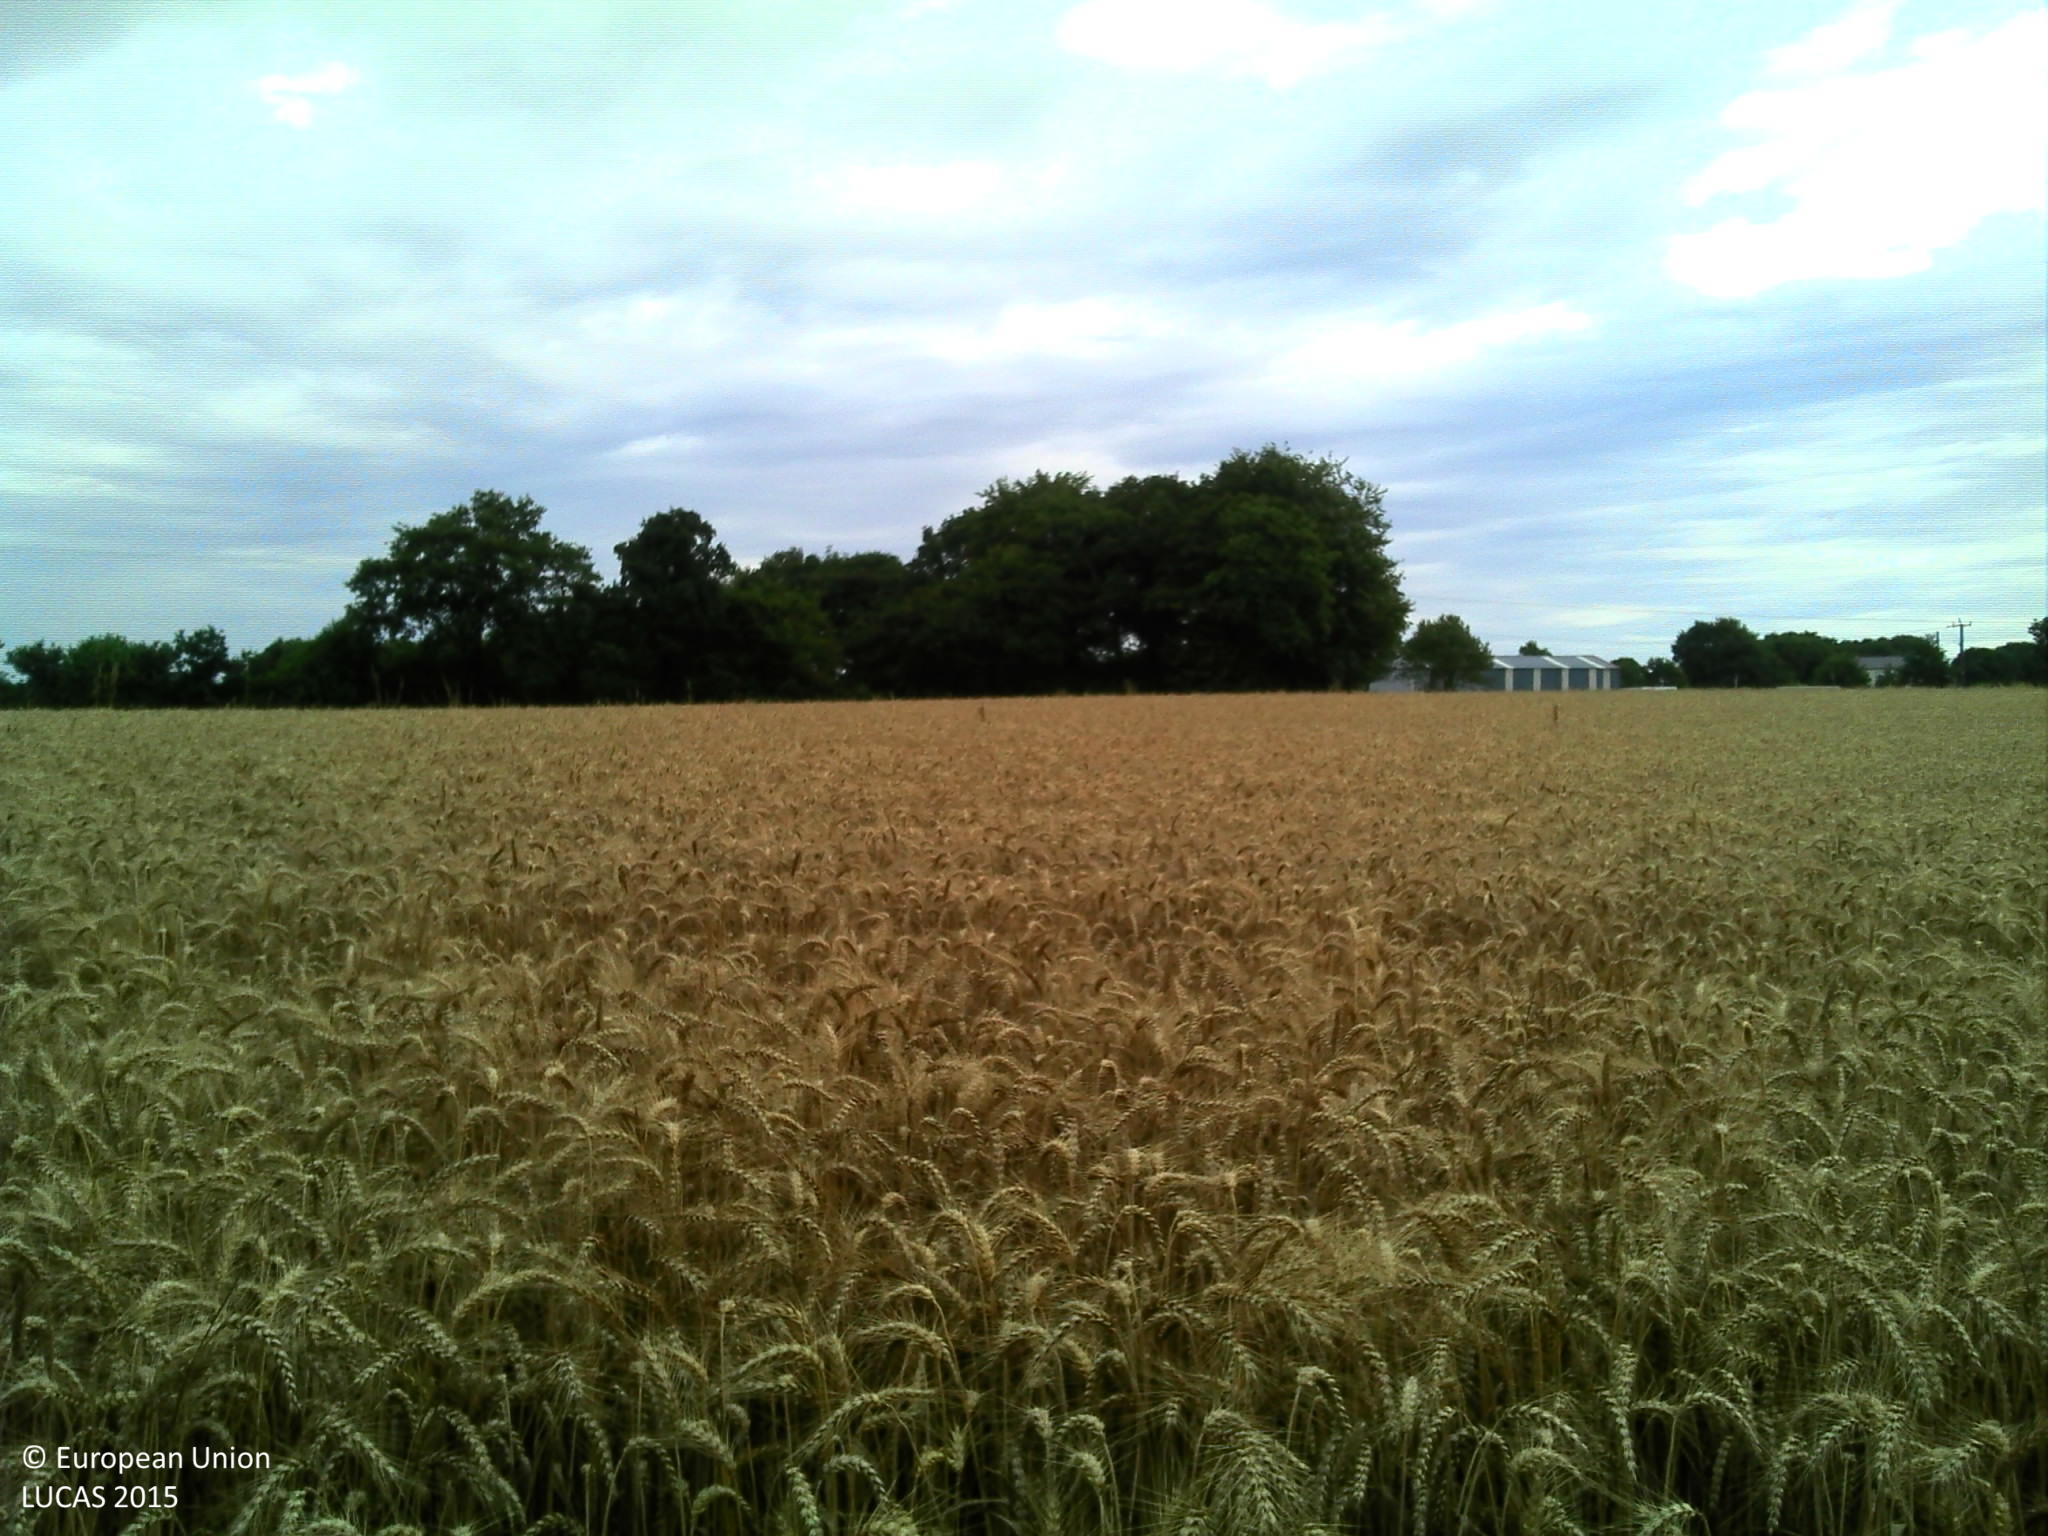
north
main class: Cropland
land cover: Common wheat
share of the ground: > 75 %
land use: Agriculture (excluding fallow land and kitchen gardens)
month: August
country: FR
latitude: 48.2681
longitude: -3.3180
